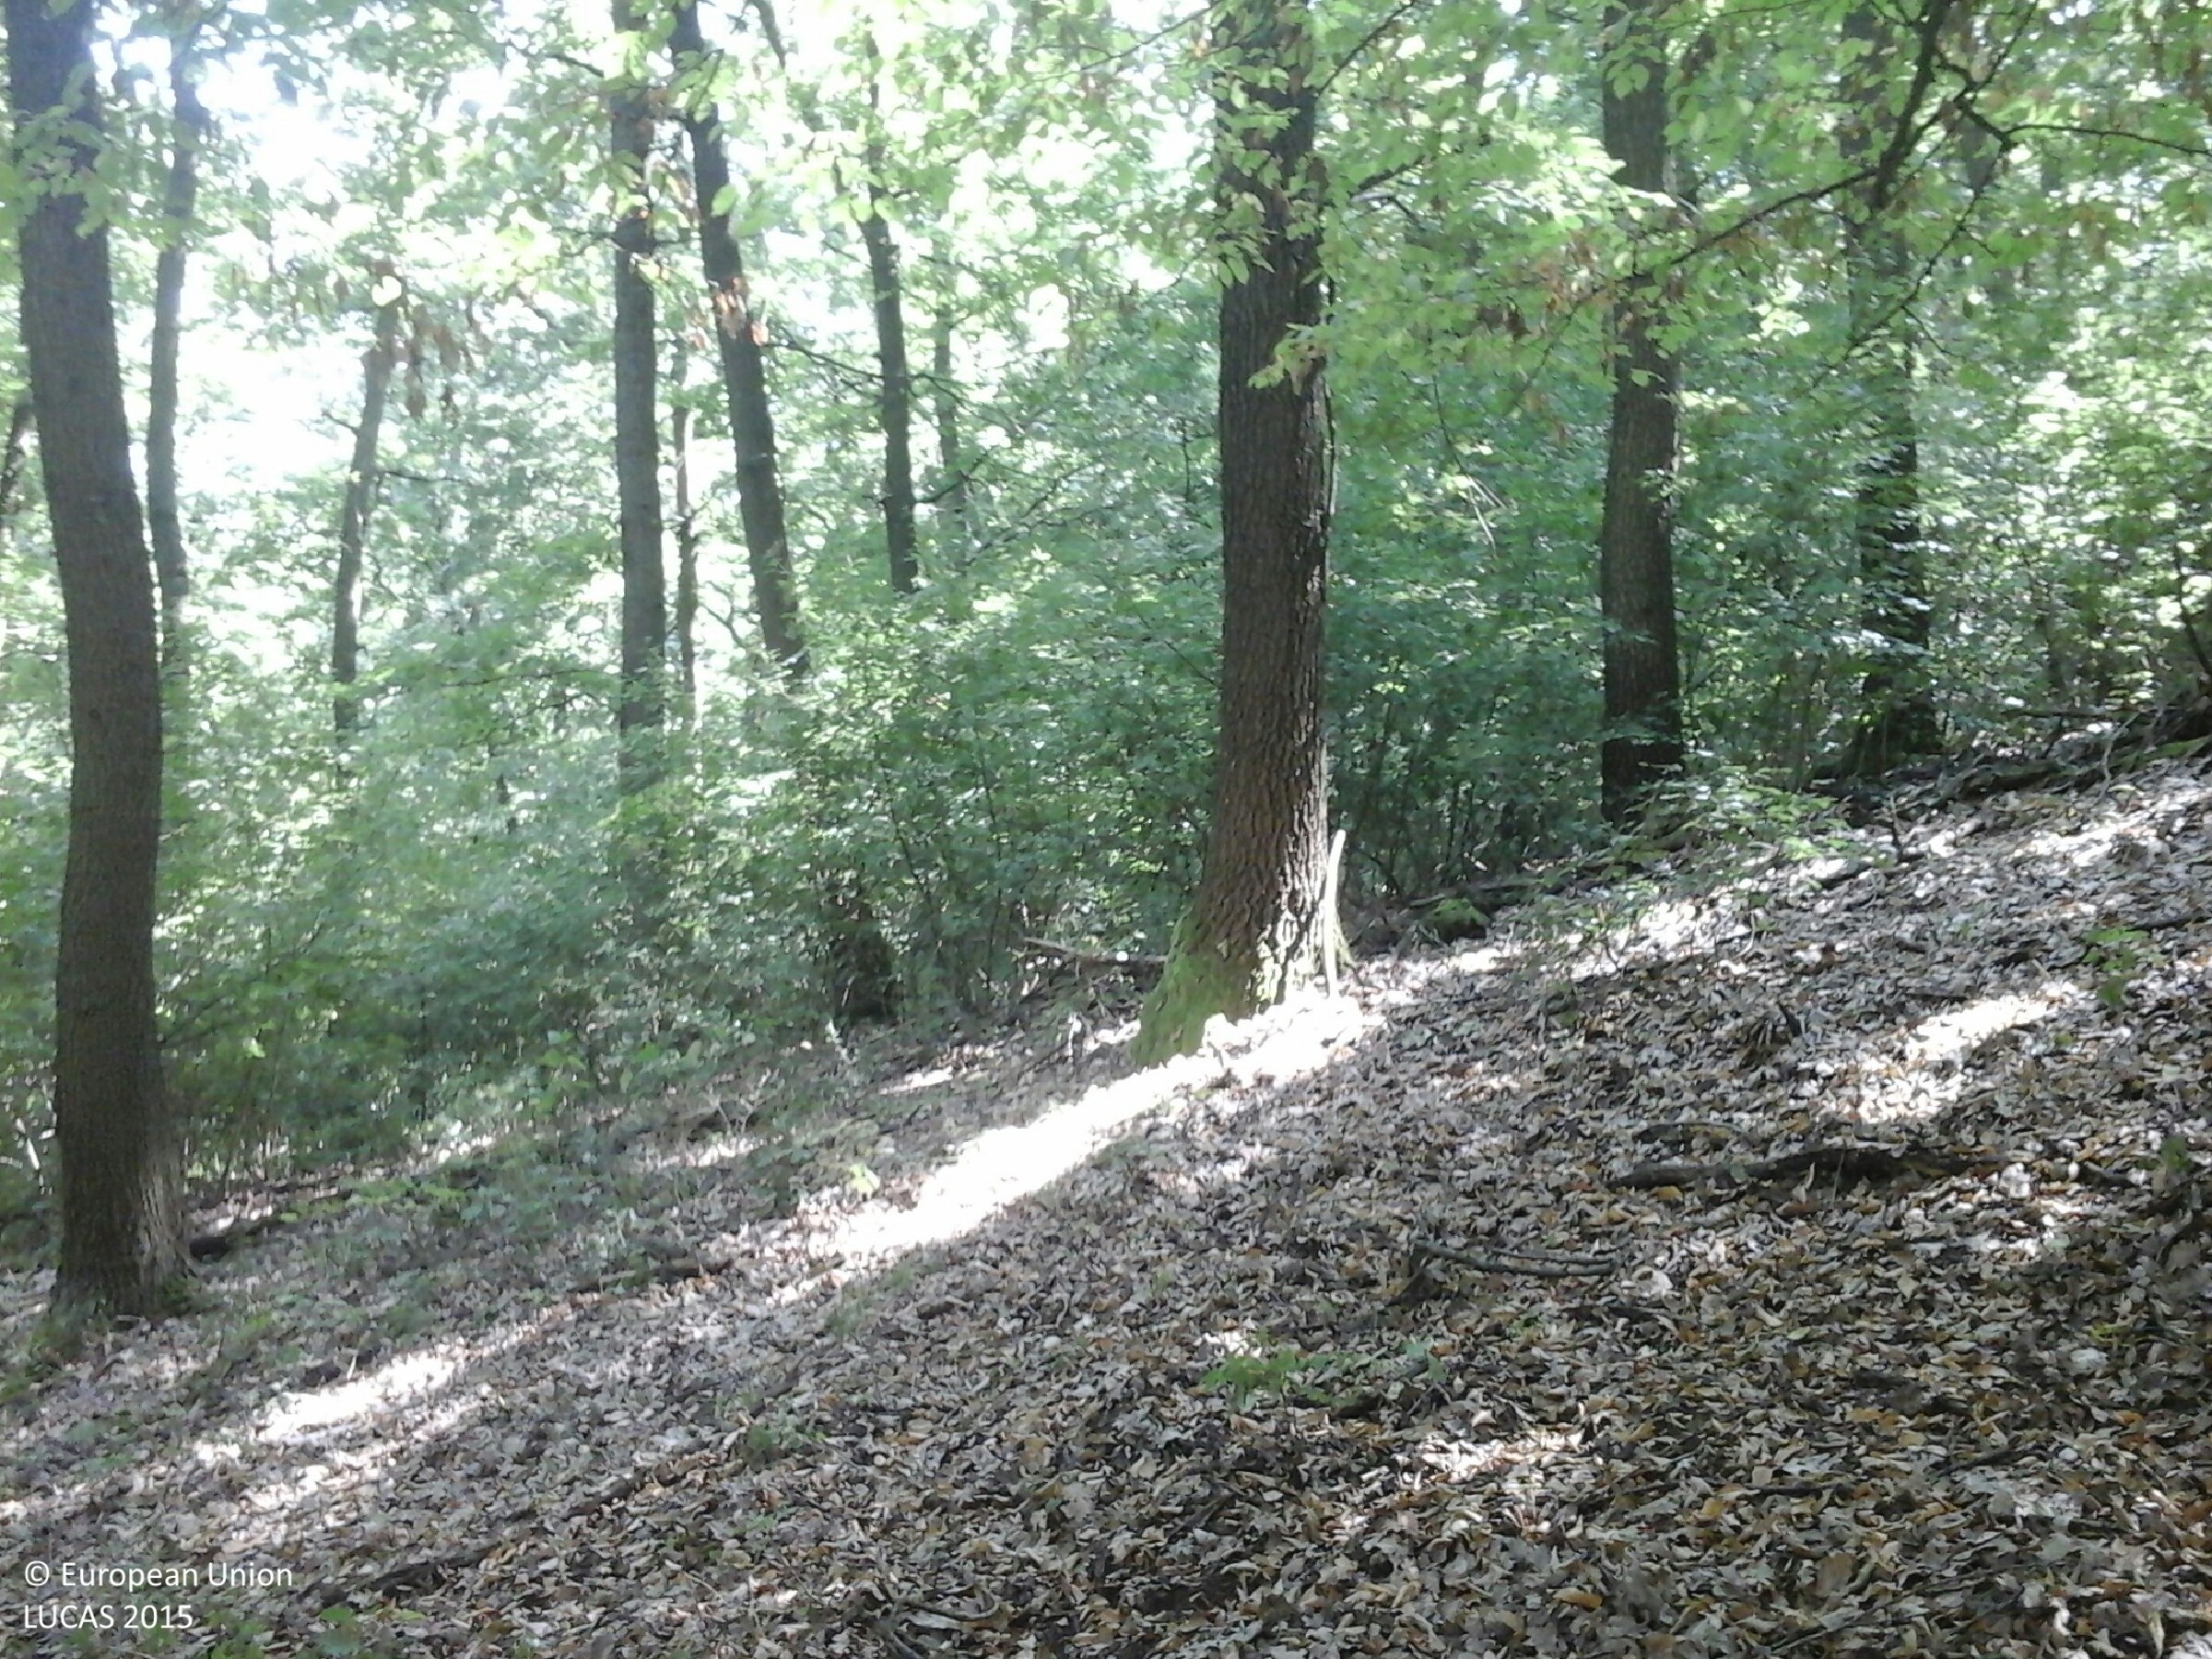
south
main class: Woodland
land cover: Broadleaved woodland
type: acidophilous oak and oak-birch forest
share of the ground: > 75 %
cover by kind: broadleaved forest trees 80 %, unconsolidated bare surface 10 %, shrubs 5 %, herbaceous plants 5 %
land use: Forestry
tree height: > 5 m
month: July
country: HU
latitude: 48.3259
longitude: 20.4325
